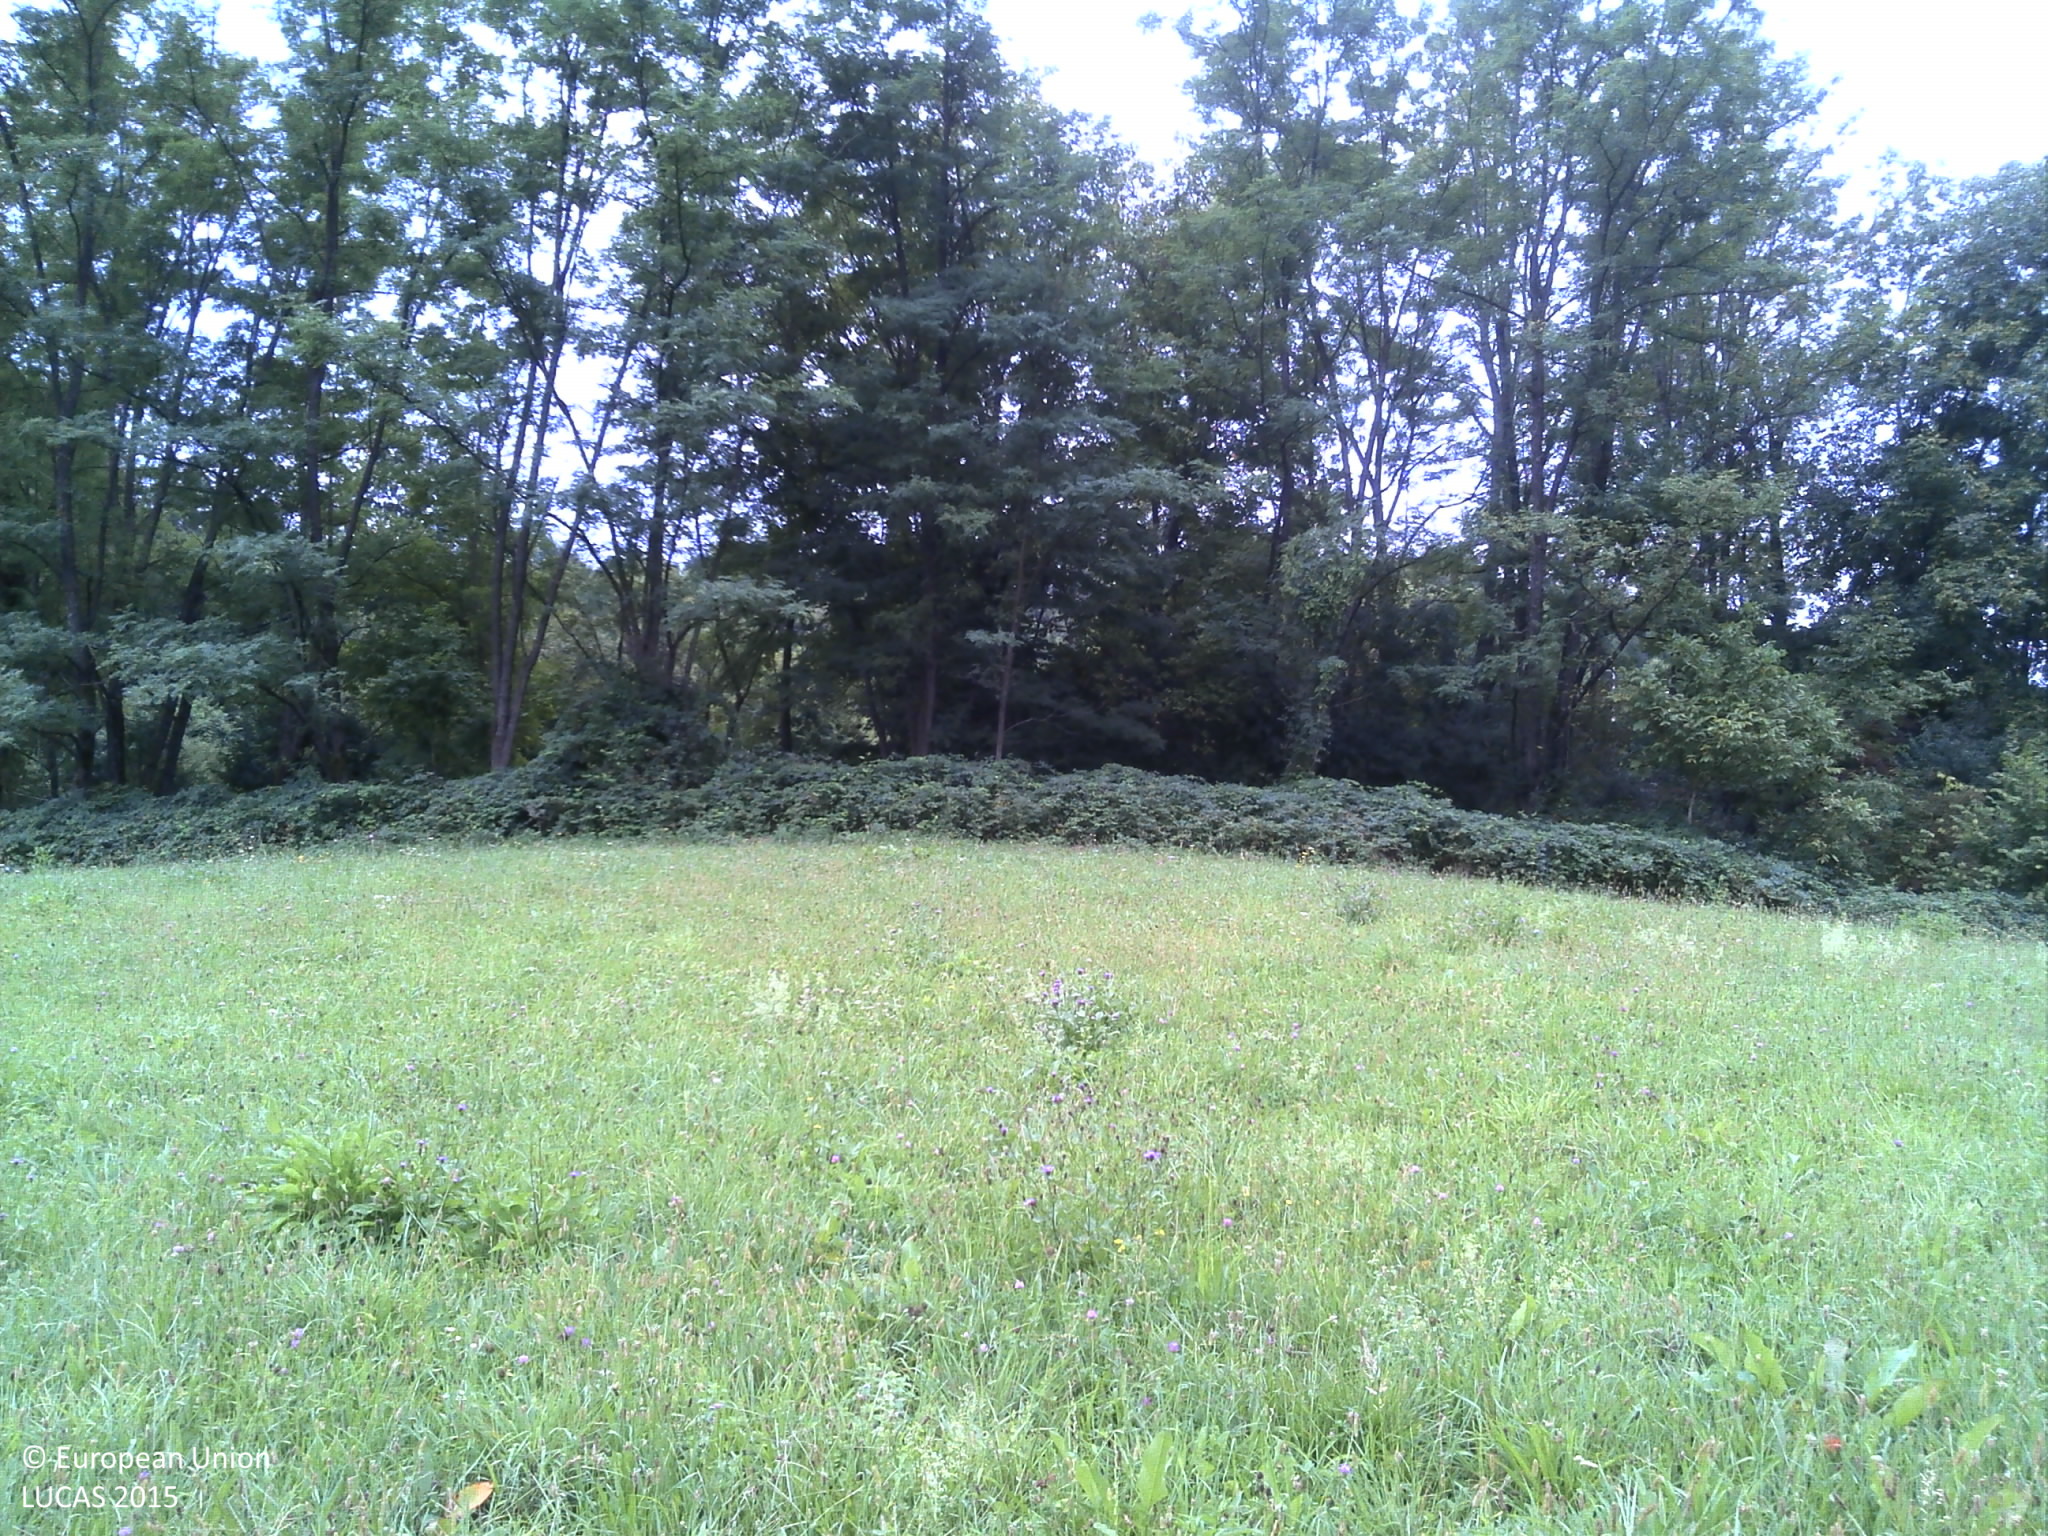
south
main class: Cropland
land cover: Clovers
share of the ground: > 75 %
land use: Agriculture (excluding fallow land and kitchen gardens)
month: September
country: HR
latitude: 45.4627
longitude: 15.2778
